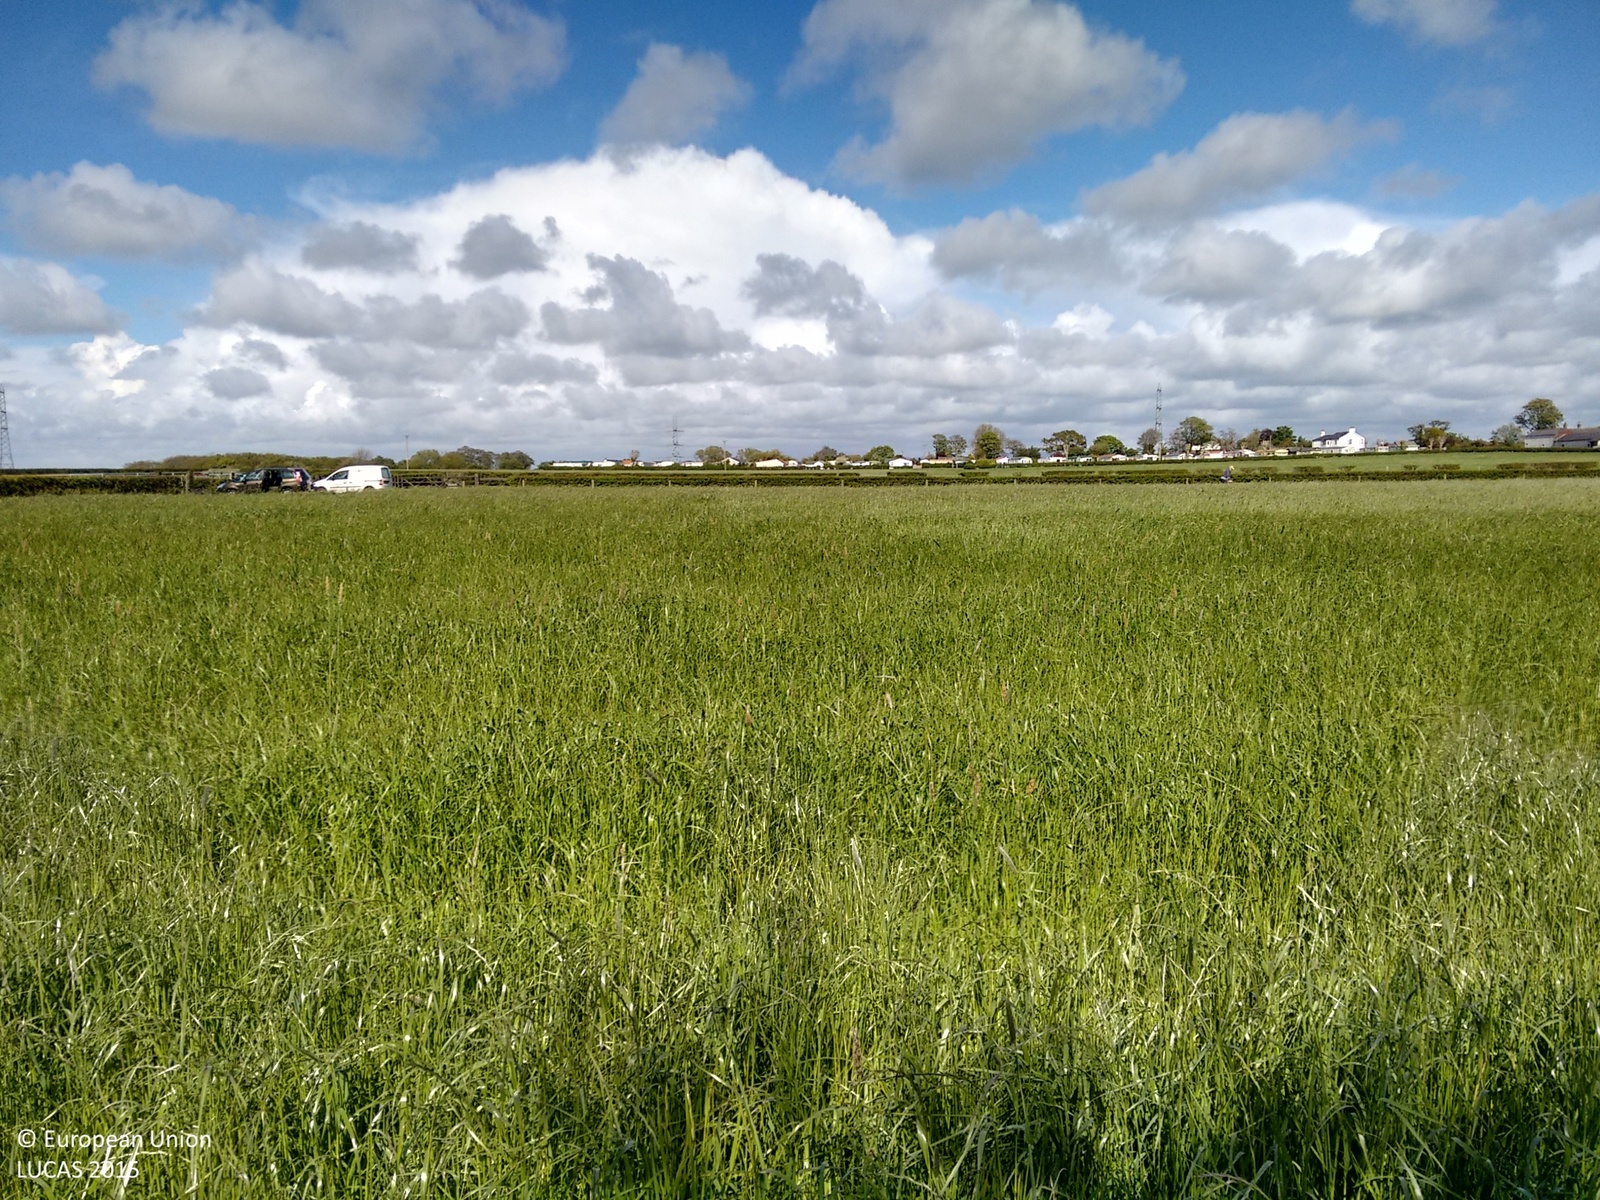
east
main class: Grassland
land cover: Grassland without tree/shrub cover
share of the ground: > 75 %
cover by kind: herbaceous plants 100 %
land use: Construction
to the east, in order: Grassland without tree/shrub cover; Fences; Grass margins; Ditches and canals; Abandoned hedges; Grassland without tree/shrub cover; Fences; Grass margins; Paved roads, cycling and walking lanes; Grass margins; Managed hedges
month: May
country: GB
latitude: 53.8542
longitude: -2.9183
